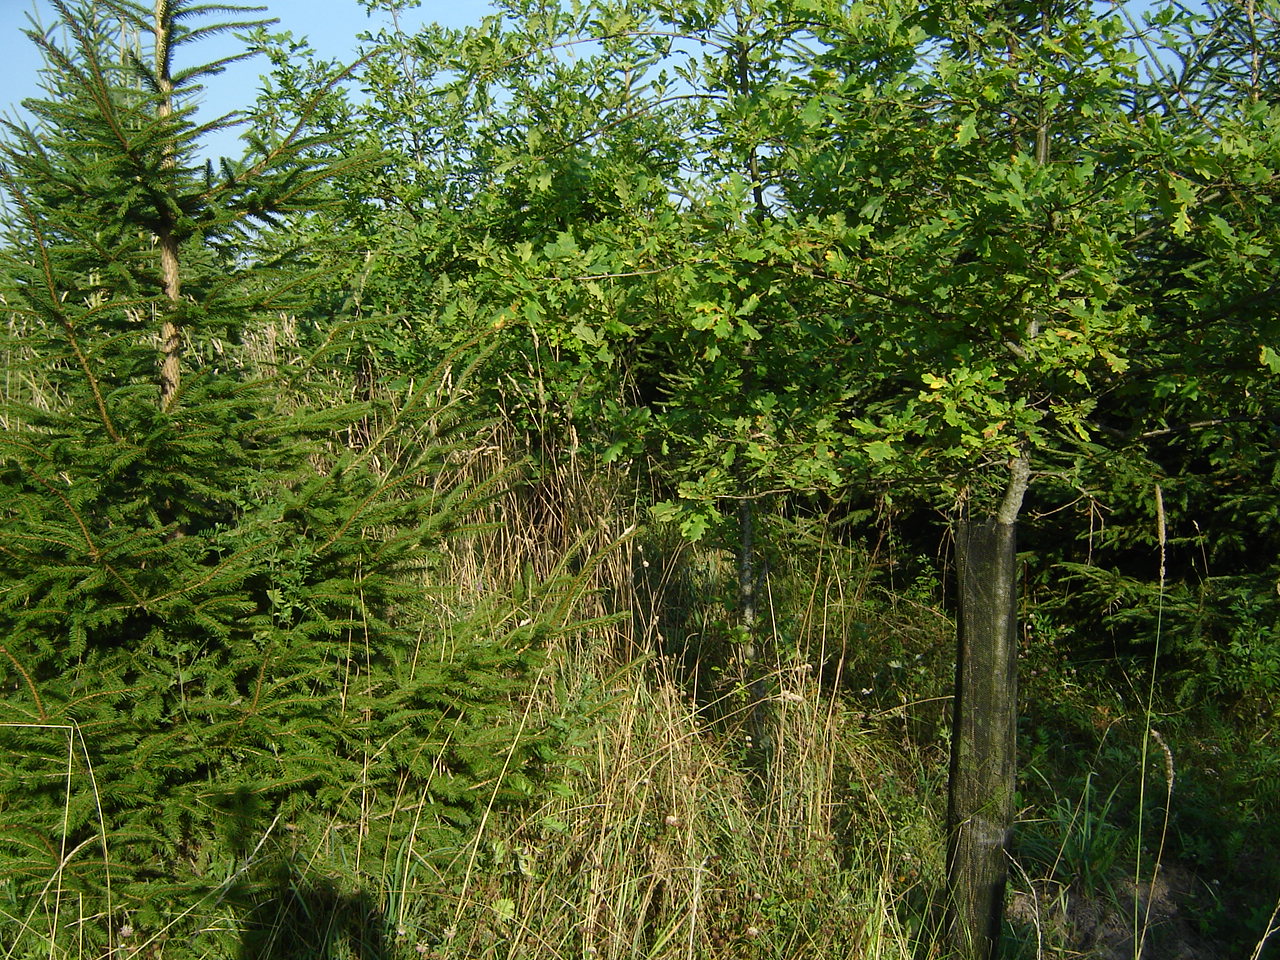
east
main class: Woodland
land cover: Spruce dominated coniferous woodland
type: hemiboreal forest and nemoral coniferous forest and mixed broadleaved-coniferous forest
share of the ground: > 75 %
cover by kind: coniferous forest trees 75 %, broadleaved forest trees 15 %, herbaceous plants 10 %
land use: Forestry
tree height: < 5 m
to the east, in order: Spruce dominated coniferous woodland; Spontaneously vegetated surfaces; Other bare soil; Electric lines; Other bare soil
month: August
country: LT
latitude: 55.2014
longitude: 24.8952
